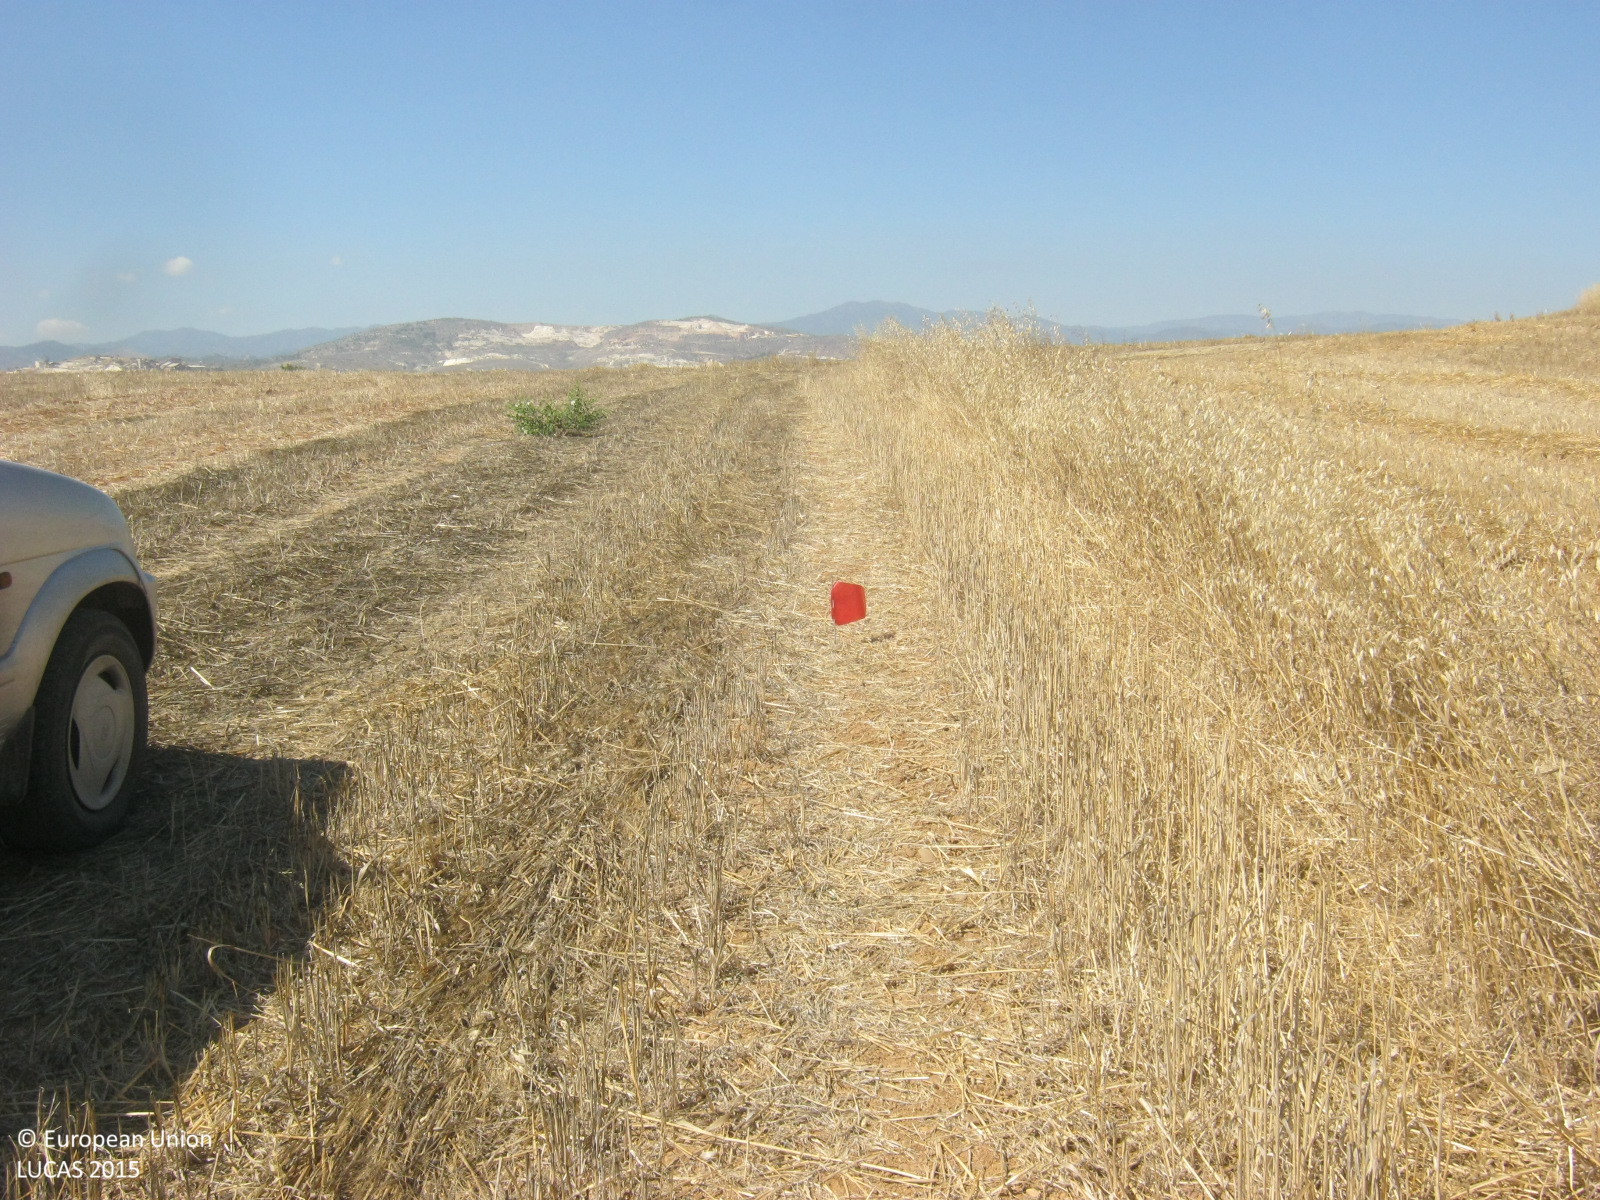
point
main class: Cropland
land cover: Common wheat
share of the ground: < 10 %
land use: Agriculture (excluding fallow land and kitchen gardens)
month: June
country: CY
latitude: 35.0953
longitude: 33.1418
